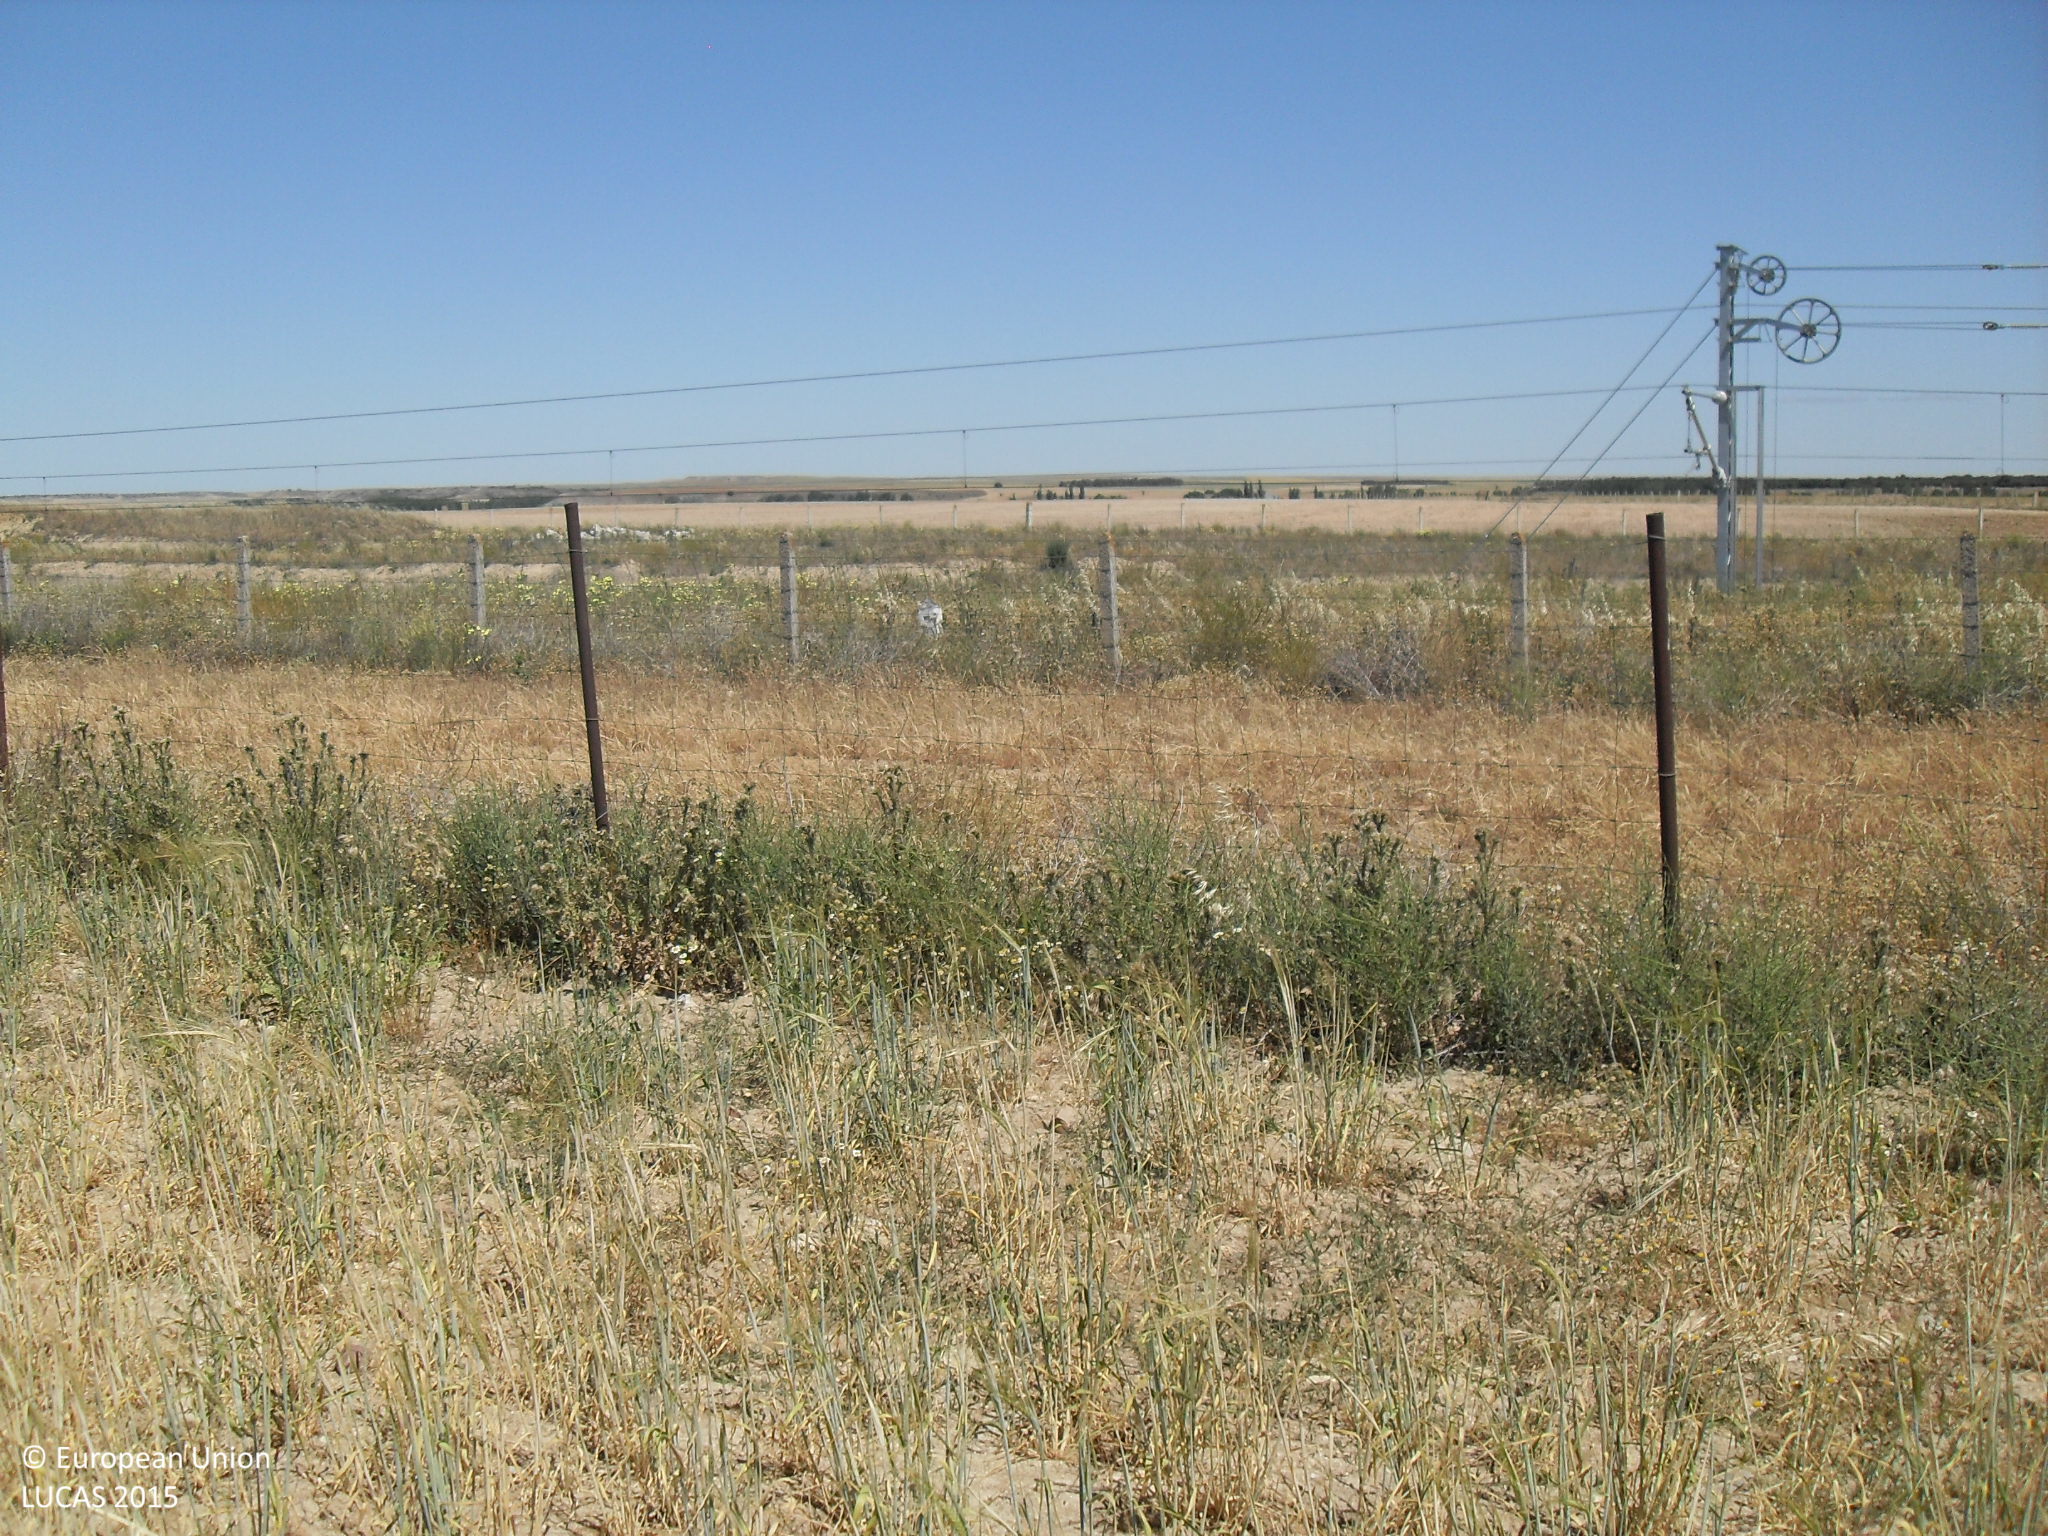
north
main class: Cropland
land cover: Barley
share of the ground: > 75 %
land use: Agriculture (excluding fallow land and kitchen gardens)
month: May
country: ES
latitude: 41.1231
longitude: -5.2578
